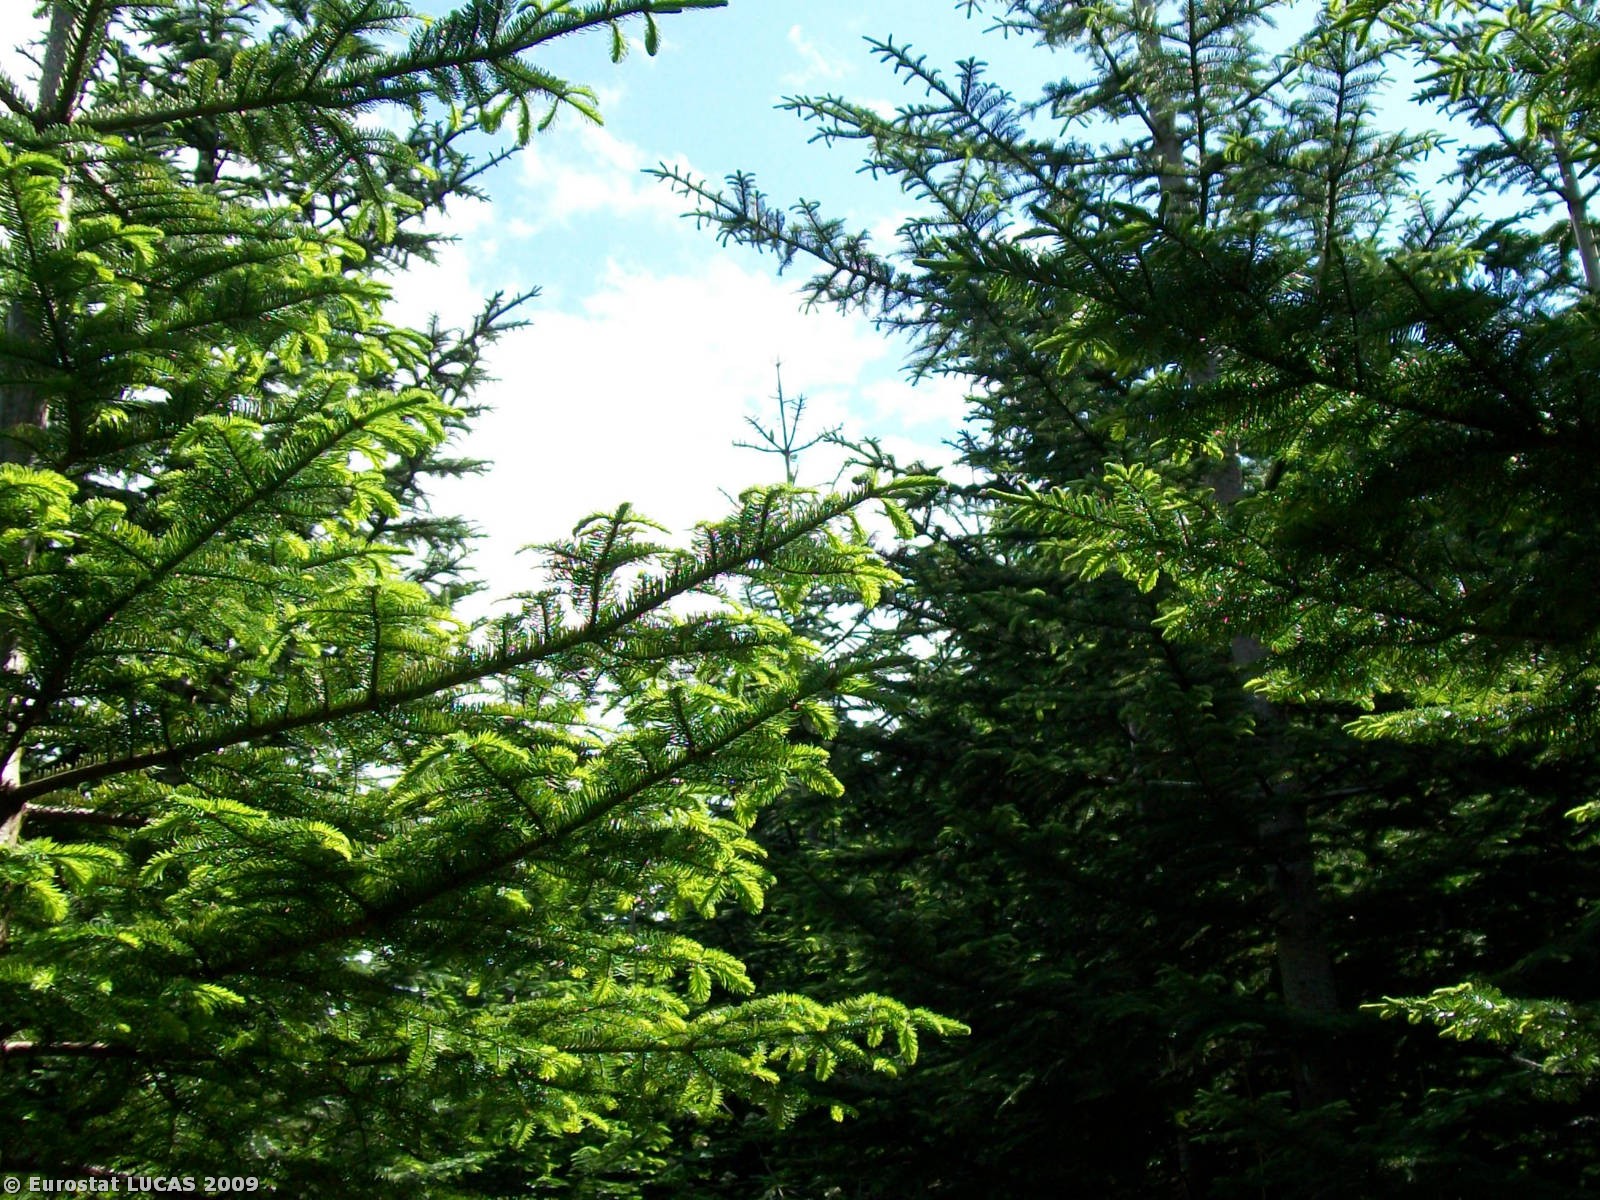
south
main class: Woodland
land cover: Coniferous woodland
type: plantations and self-sown exotic forest
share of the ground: 50 - 75 %
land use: Forestry
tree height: > 5 m
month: June
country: GB
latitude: 56.5048
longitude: -5.3398
